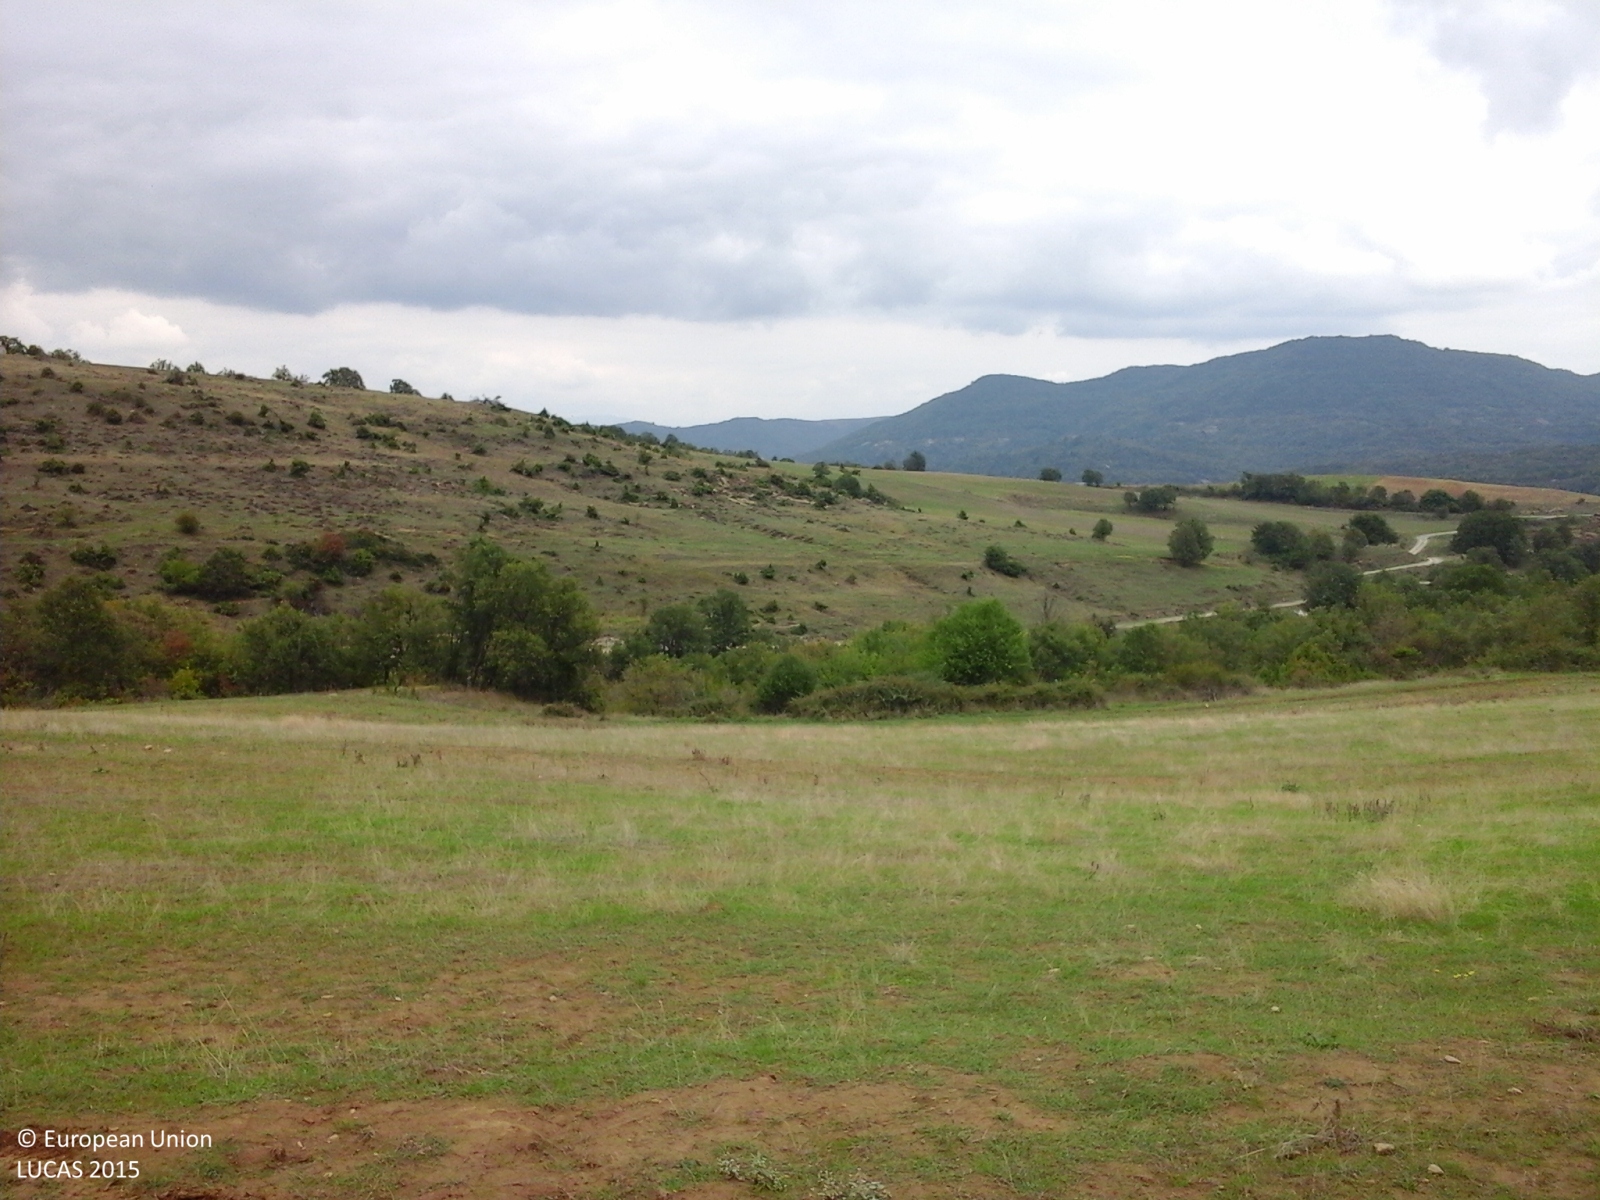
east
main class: Grassland
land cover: Spontaneously vegetated surfaces
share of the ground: > 75 %
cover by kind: herbaceous plants 75 %, unconsolidated bare surface 25 %
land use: Fallow land
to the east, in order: Spontaneously vegetated surfaces; Shrubland with sparse tree cover; Broadleaved woodland; Grassland with sparse tree/shrub cover; Broadleaved woodland; Rivers and streams; Broadleaved woodland; Tracks; Grassland with sparse tree/shrub cover
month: October
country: GR
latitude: 40.3839
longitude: 21.0955
